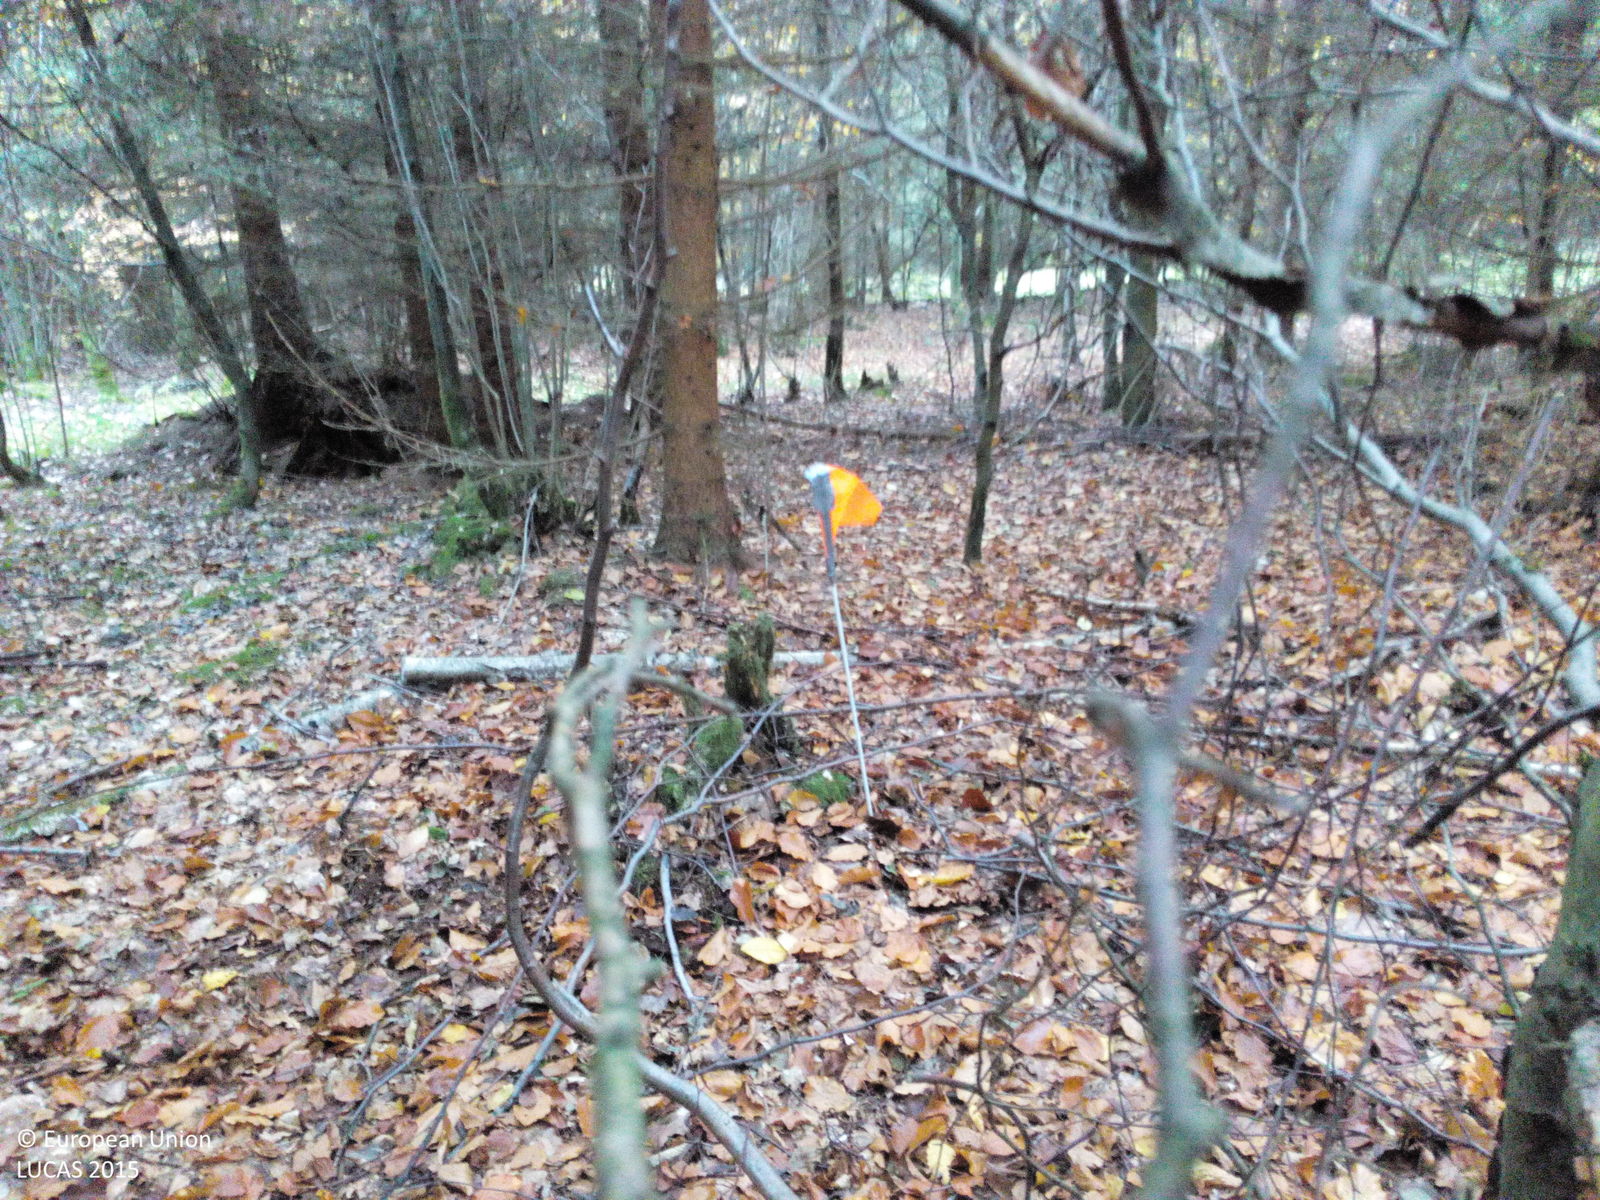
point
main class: Woodland
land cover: Spruce dominated mixed woodland
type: hemiboreal forest and nemoral coniferous forest and mixed broadleaved-coniferous forest
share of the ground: > 75 %
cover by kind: coniferous forest trees 45 %, broadleaved forest trees 30 %, lichens and mosses 15 %, unconsolidated bare surface 10 %
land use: Forestry
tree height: > 5 m
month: October
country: DE
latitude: 50.3280
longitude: 9.9017
